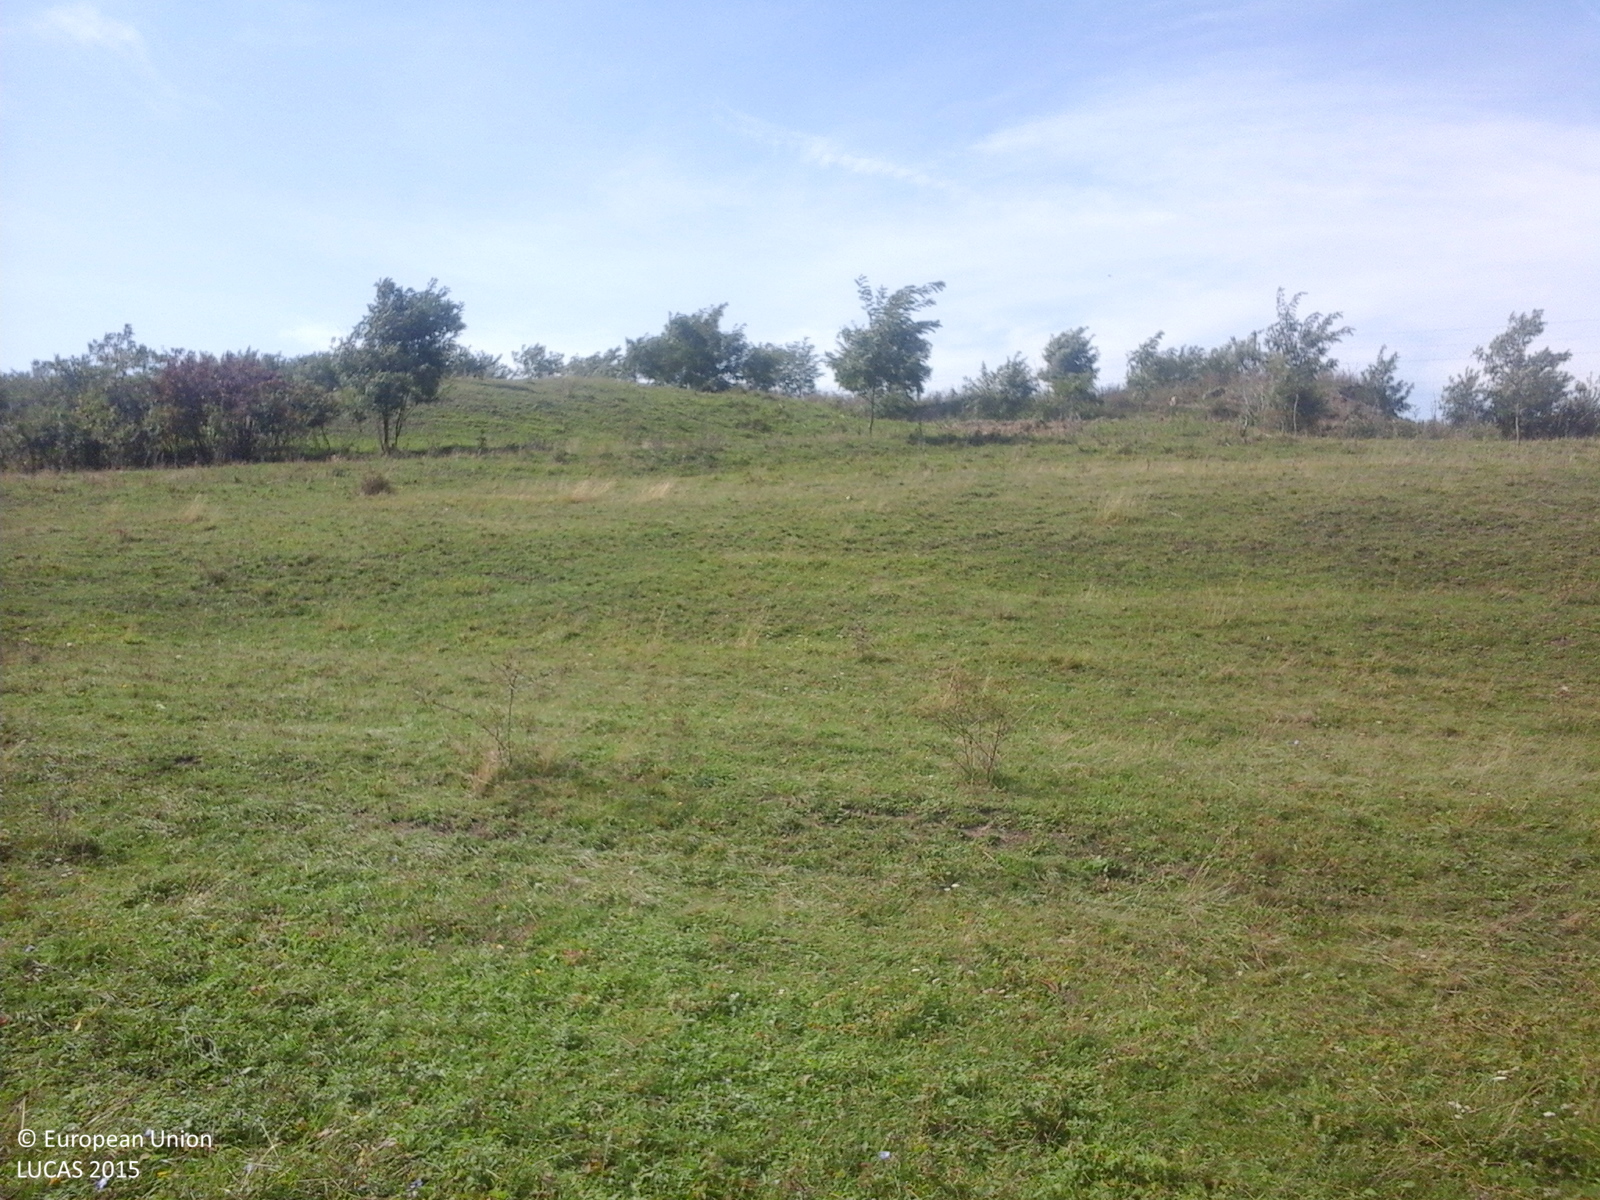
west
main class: Grassland
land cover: Grassland without tree/shrub cover
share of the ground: > 75 %
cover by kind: herbaceous plants 100 %
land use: Agriculture (excluding fallow land and kitchen gardens)
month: September
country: RO
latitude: 46.7053
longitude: 23.8481
